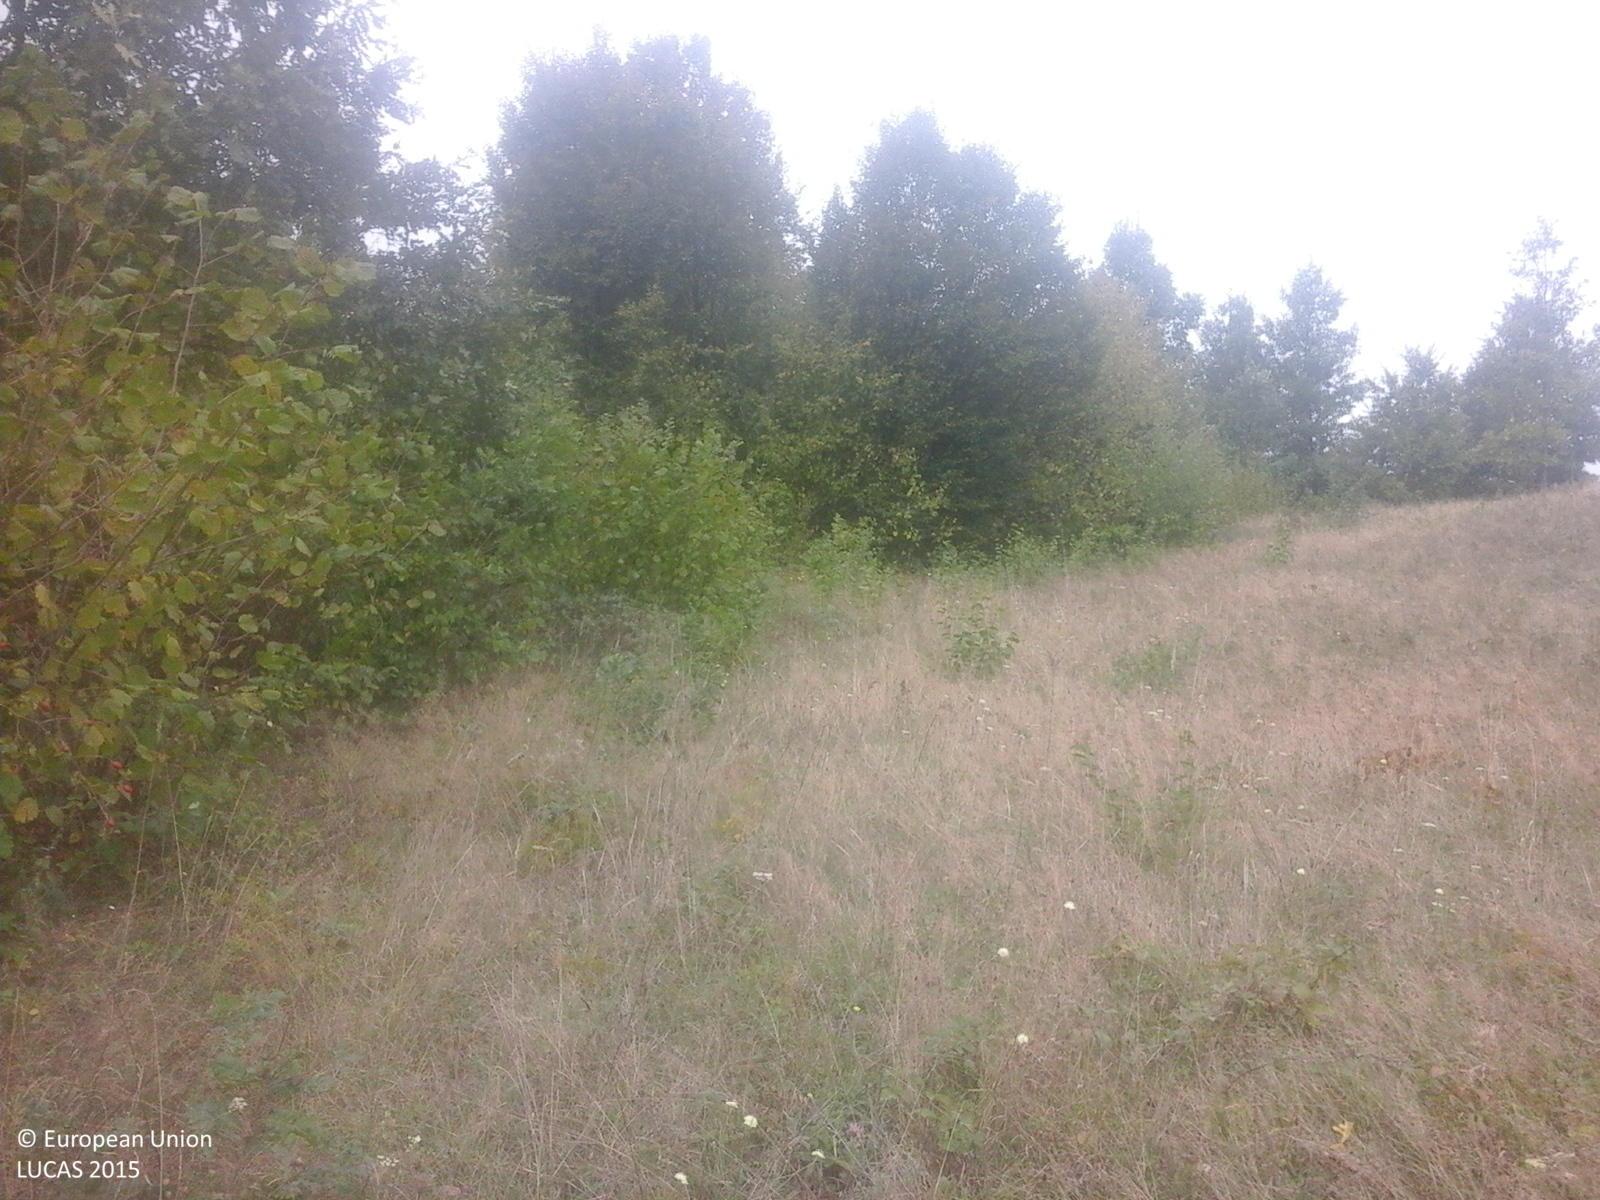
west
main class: Grassland
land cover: Grassland without tree/shrub cover
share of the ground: > 75 %
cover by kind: herbaceous plants 100 %
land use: Agriculture (excluding fallow land and kitchen gardens)
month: September
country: RO
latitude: 45.8663
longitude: 22.0599
